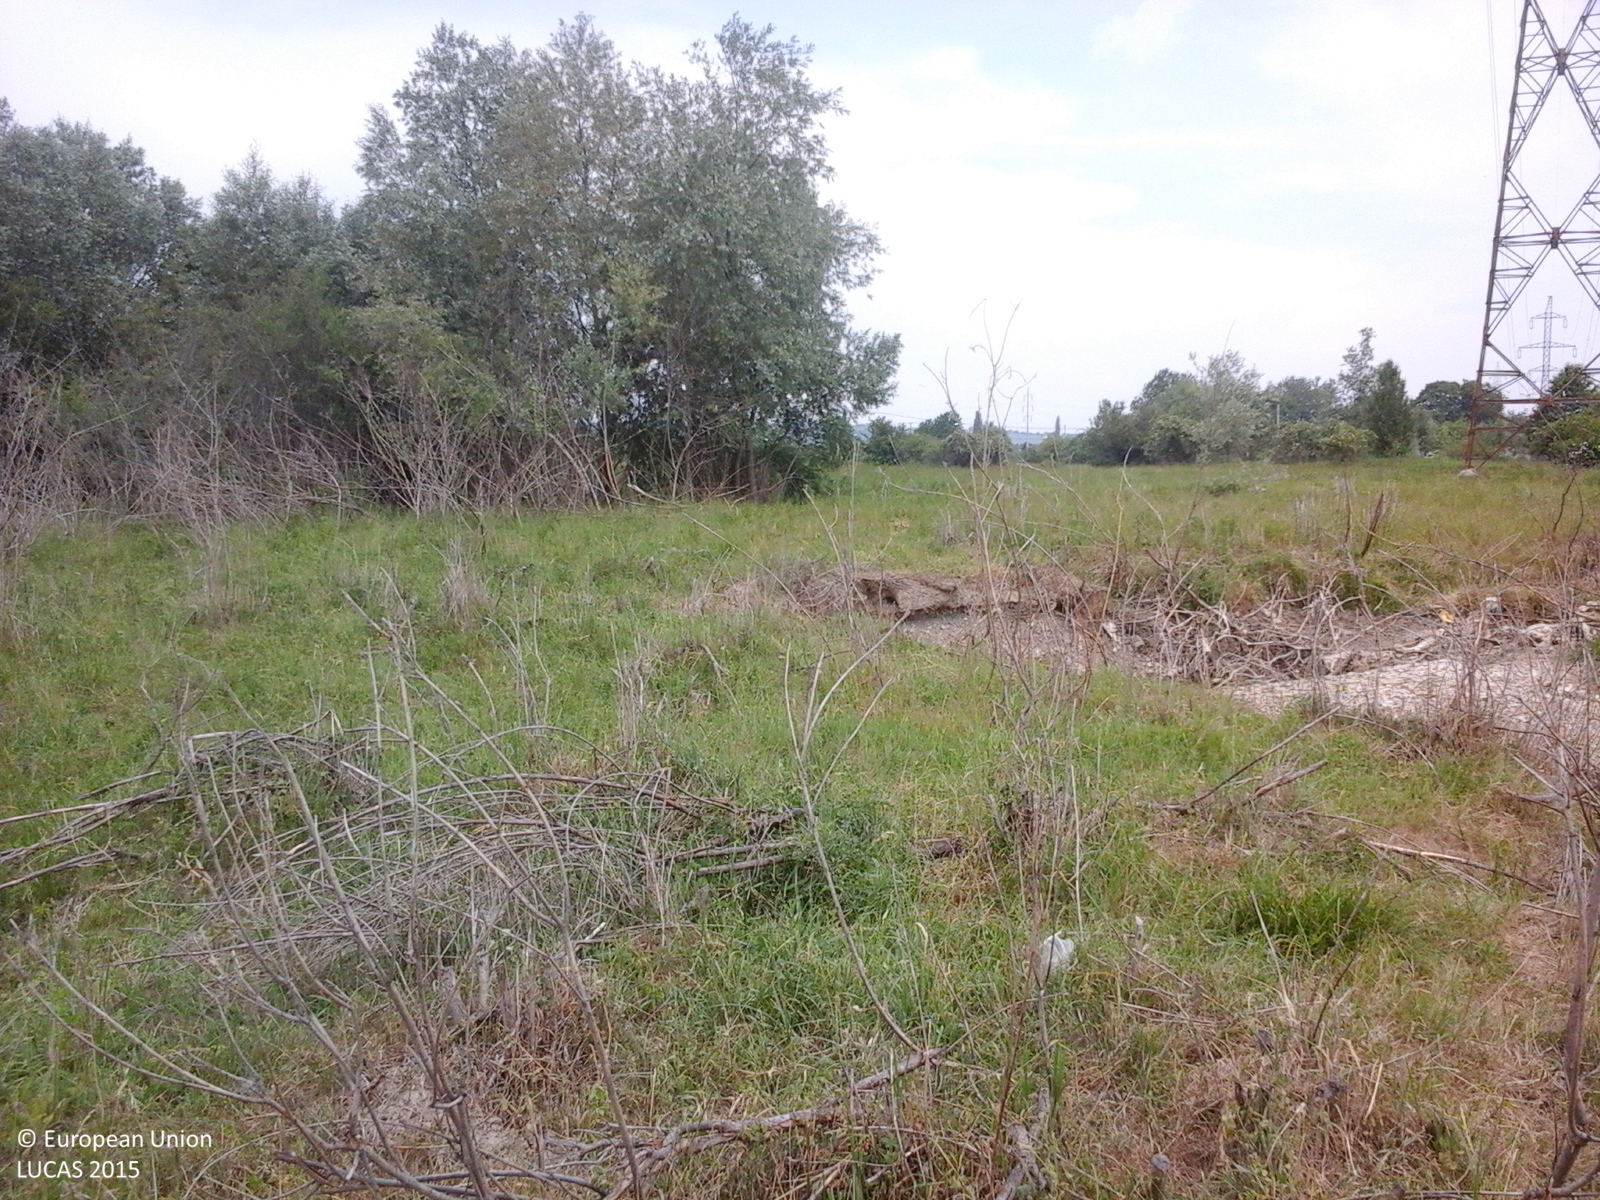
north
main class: Artificial land
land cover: Non built-up linear features
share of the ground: > 75 %
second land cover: Spontaneously vegetated surfaces
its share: > 75 %
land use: Electricity, gas and thermal power distribution
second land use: Agriculture (excluding fallow land and kitchen gardens)
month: June
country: RO
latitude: 47.2023
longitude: 26.4142
